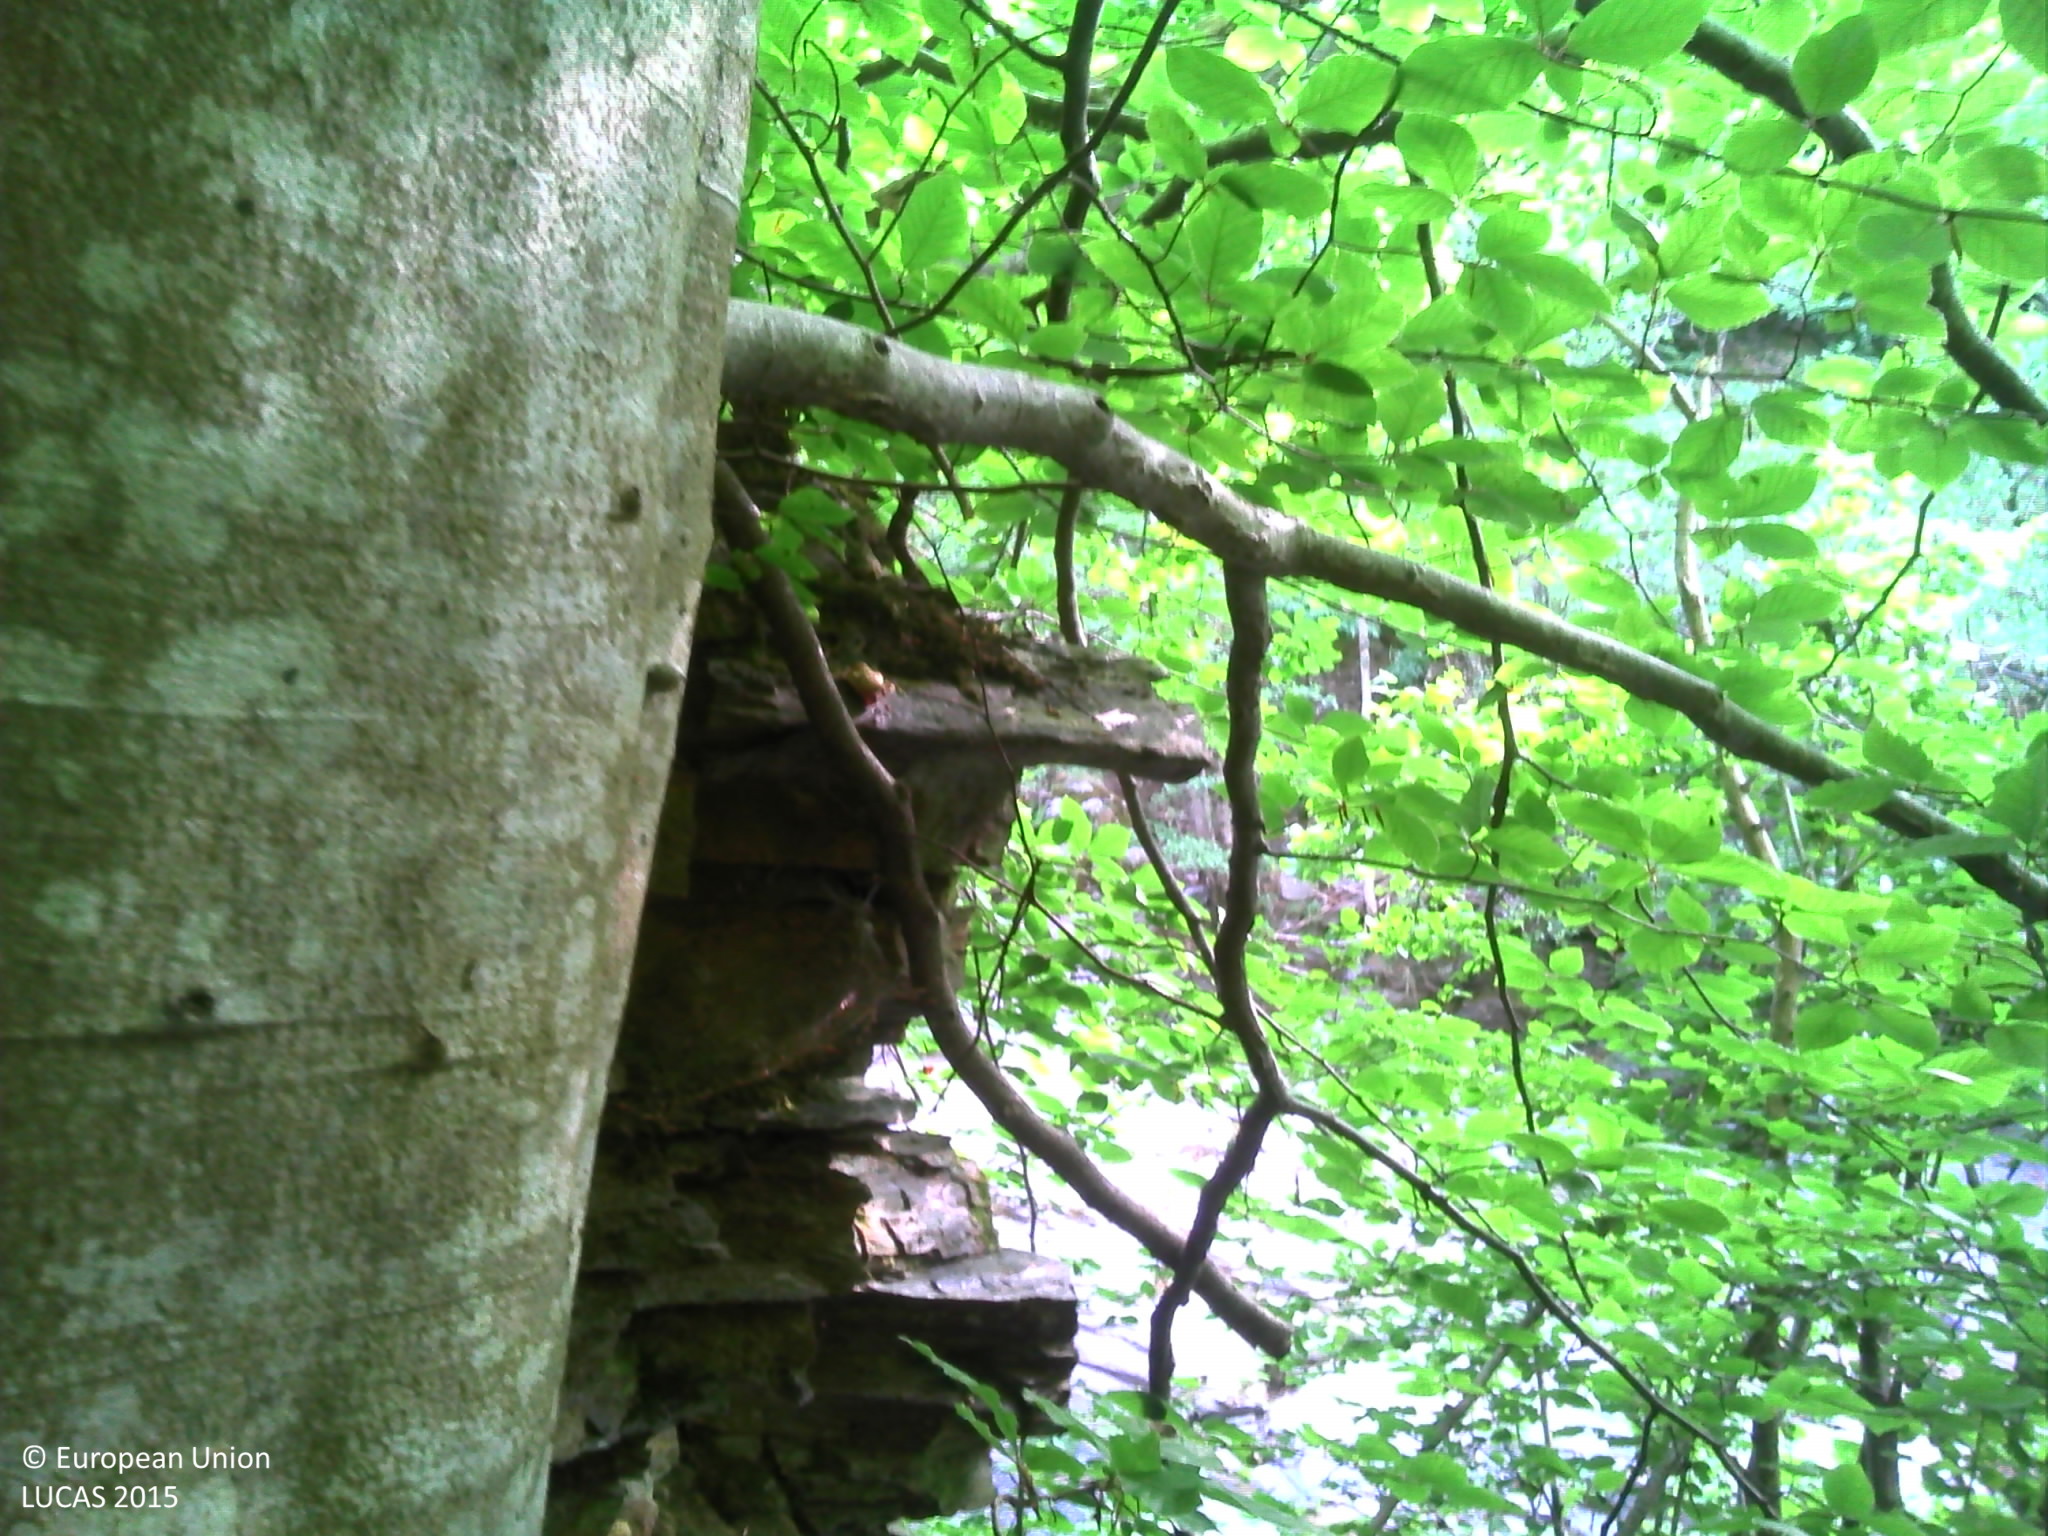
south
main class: Woodland
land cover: Broadleaved woodland
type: beech forest
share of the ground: > 75 %
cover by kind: broadleaved forest trees 85 %, herbaceous plants 10 %, coniferous forest trees 5 %
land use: Forestry
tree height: > 5 m
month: June
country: FR
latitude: 44.4251
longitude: 3.9142
